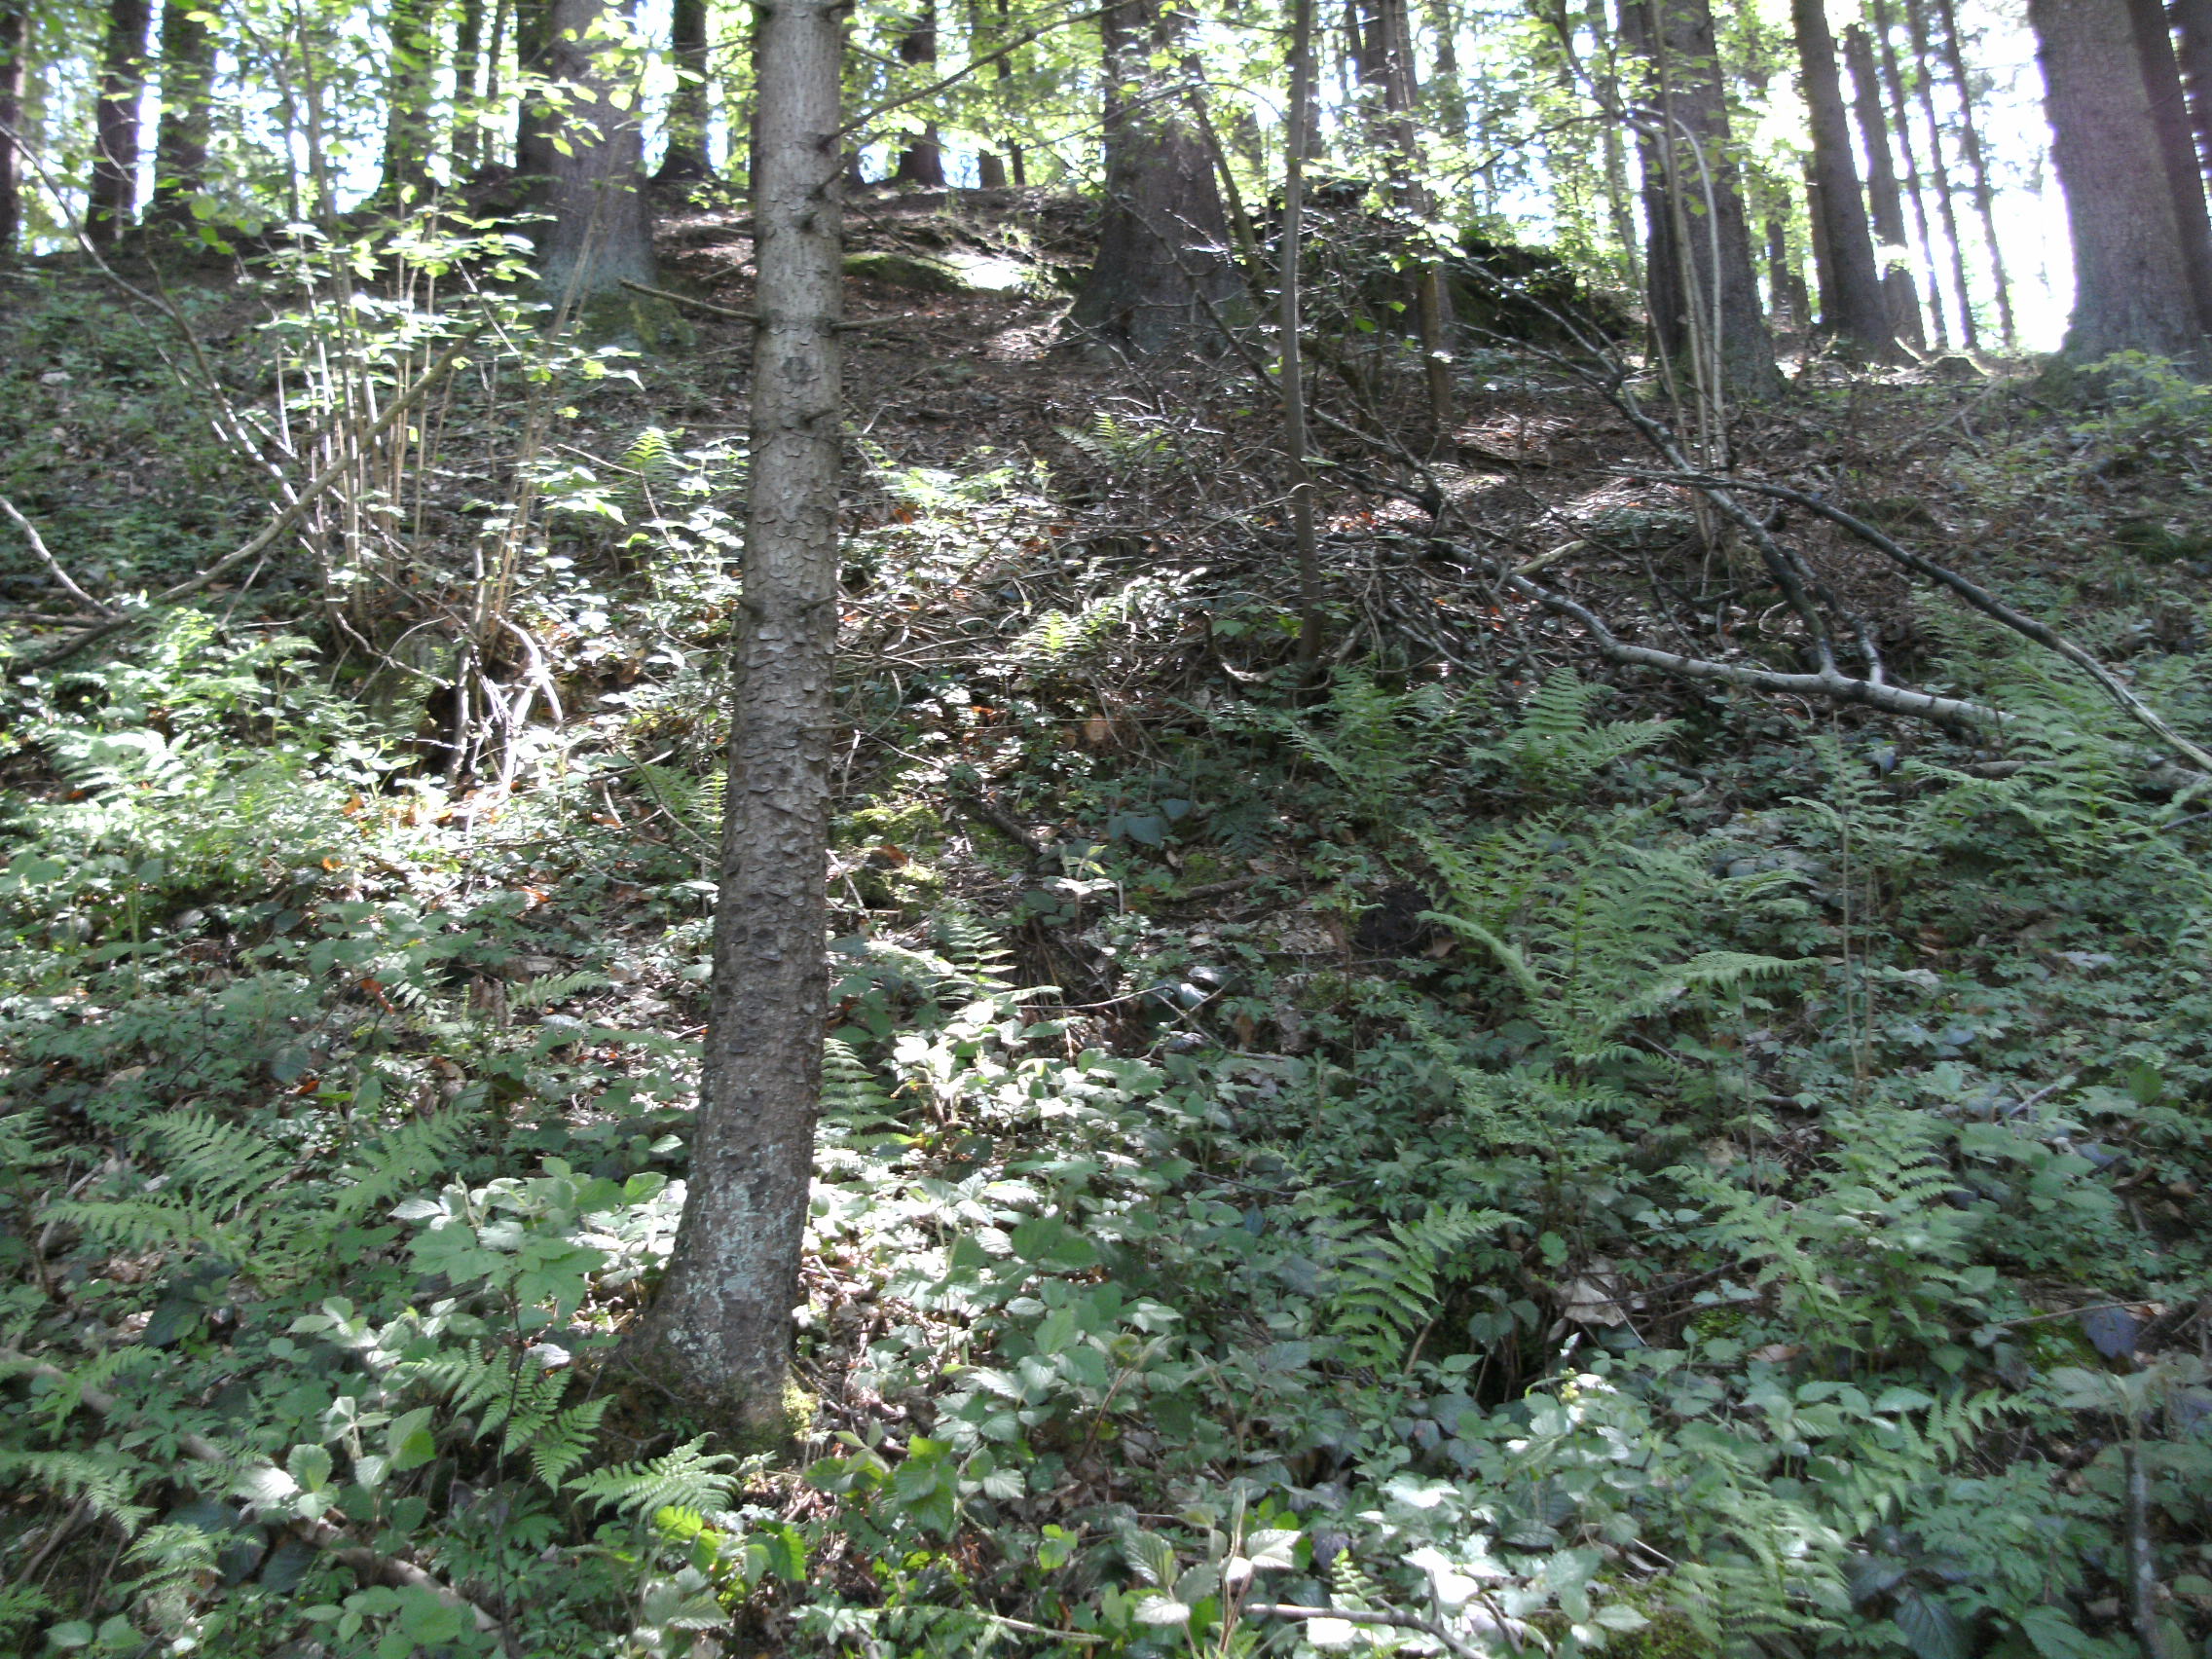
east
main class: Woodland
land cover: Spruce dominated mixed woodland
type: hemiboreal forest and nemoral coniferous forest and mixed broadleaved-coniferous forest
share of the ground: > 75 %
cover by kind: broadleaved forest trees 75 %, coniferous forest trees 25 %
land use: Forestry
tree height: > 5 m
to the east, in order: Spruce dominated mixed woodland; Tracks; Spruce dominated mixed woodland; Grassland without tree/shrub cover; Single bushes/trees; Paved roads, cycling and walking lanes; Ditches and canals; Grassland without tree/shrub cover; Paved roads, cycling and walking lanes; Ditches and canals; Grassland without tree/shrub cover; Apple fruit; Grassland without tree/shrub cover; Artificial constructions in urban areas
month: May
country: AT
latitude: 48.4938
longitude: 13.4502
